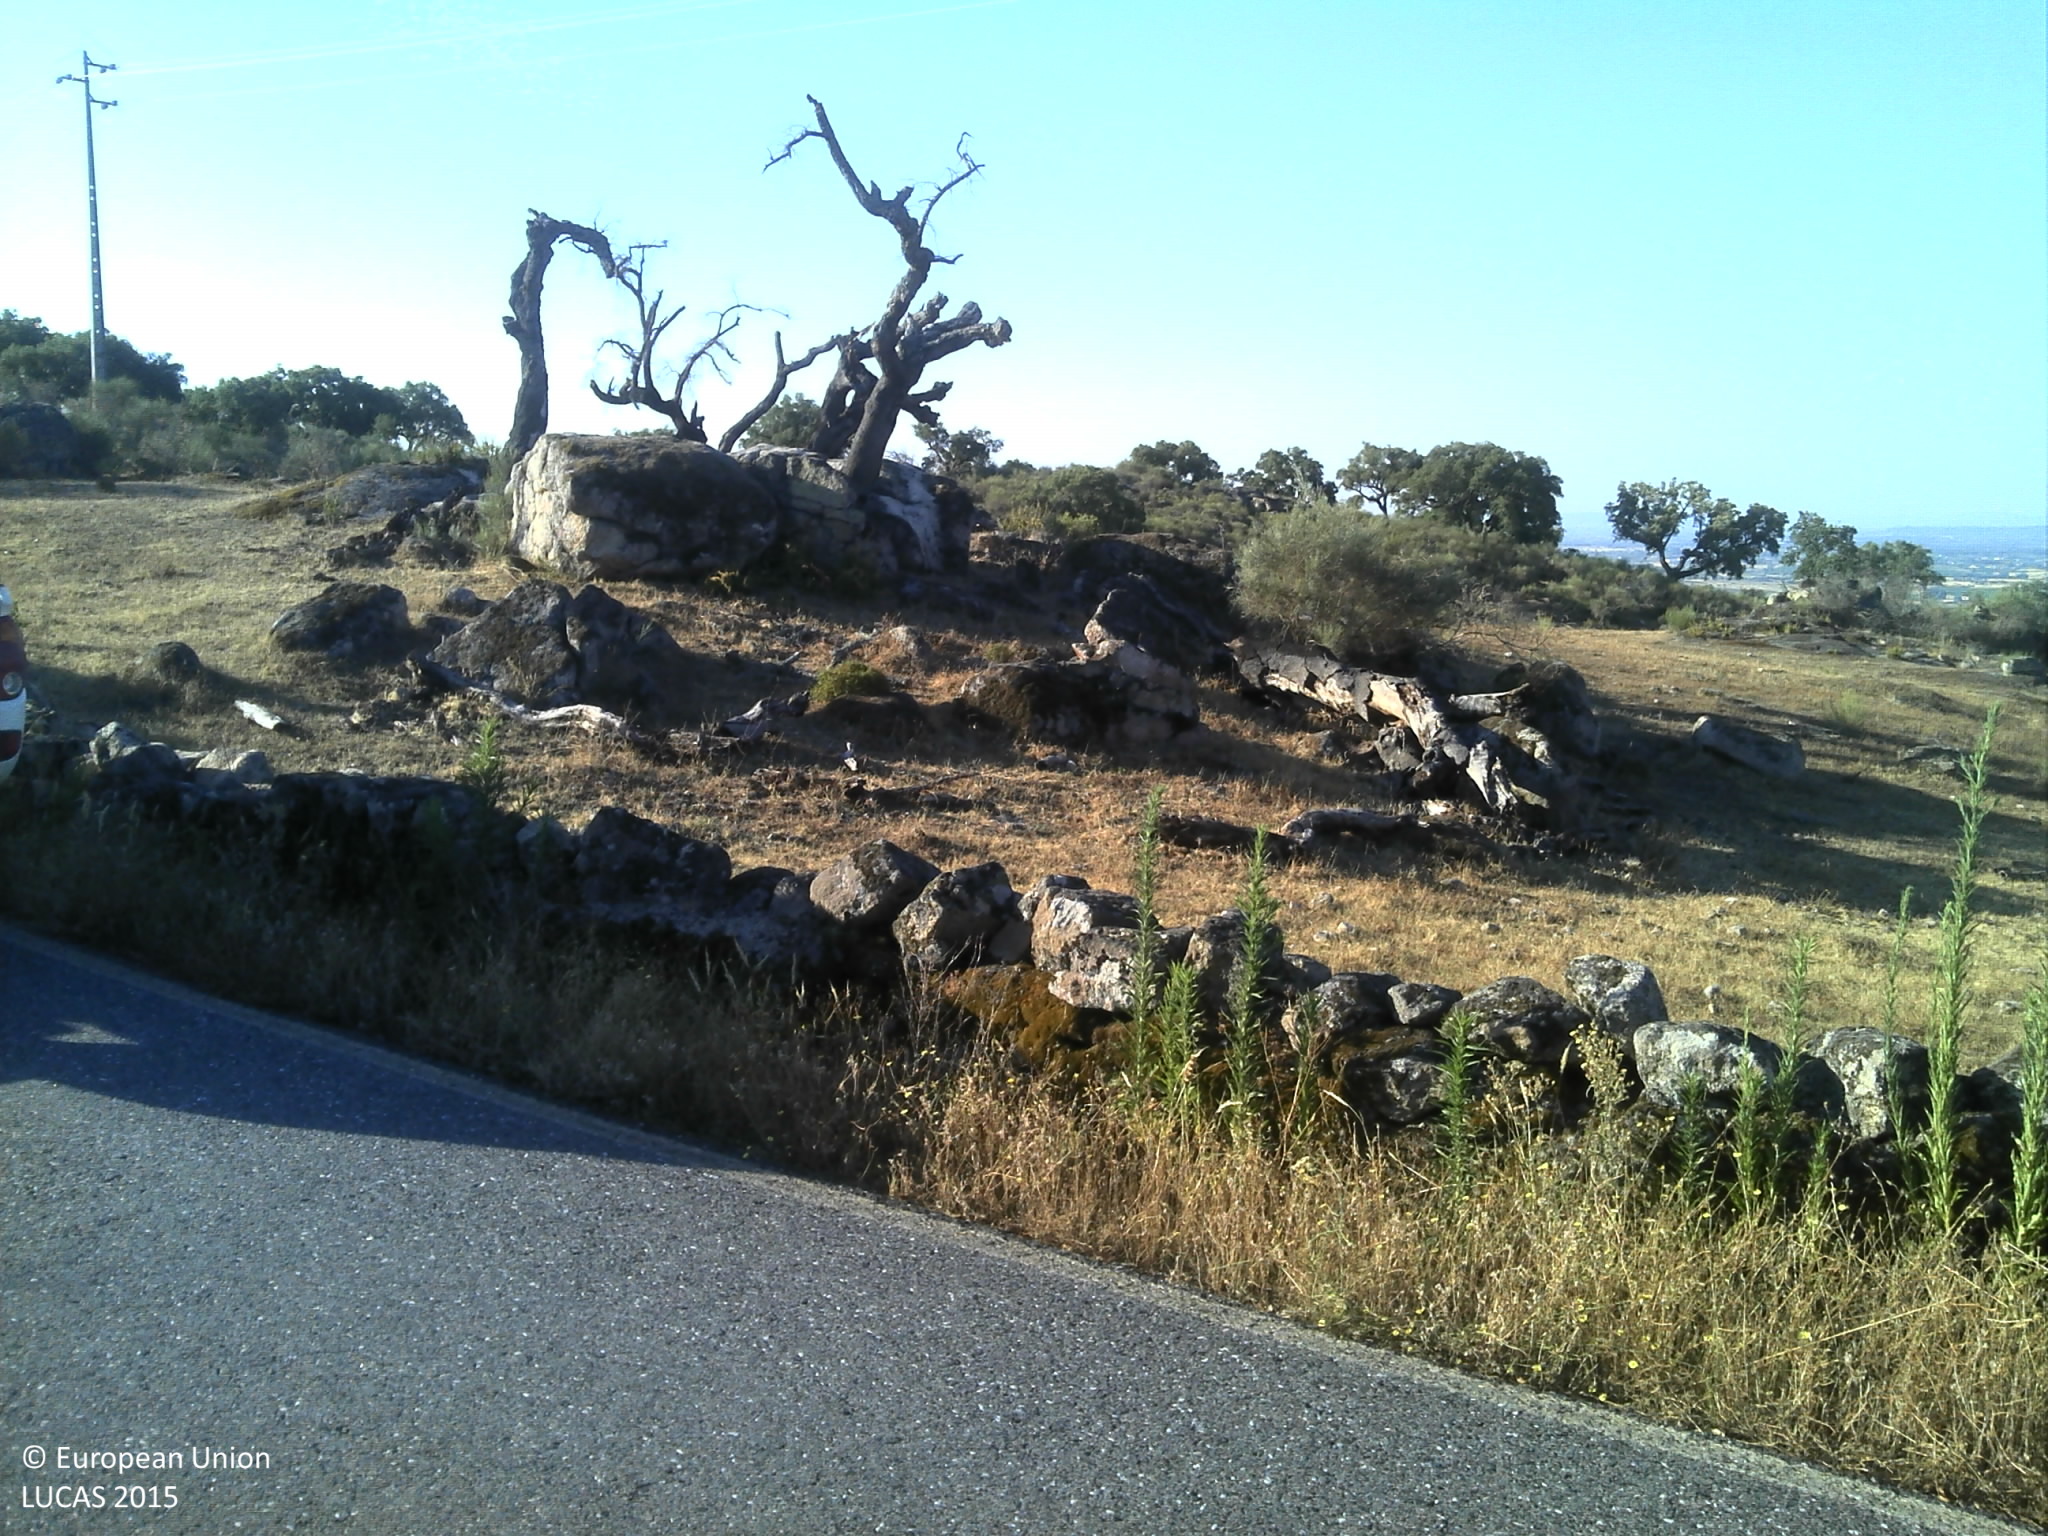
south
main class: Woodland
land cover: Broadleaved woodland
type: broadleaved evergreen forest
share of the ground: 25 - 50 %
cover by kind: broadleaved forest trees 45 %, herbaceous plants 30 %, unconsolidated bare surface 20 %
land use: Forestry
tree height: > 5 m
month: June
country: PT
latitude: 39.9239
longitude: -7.2595
